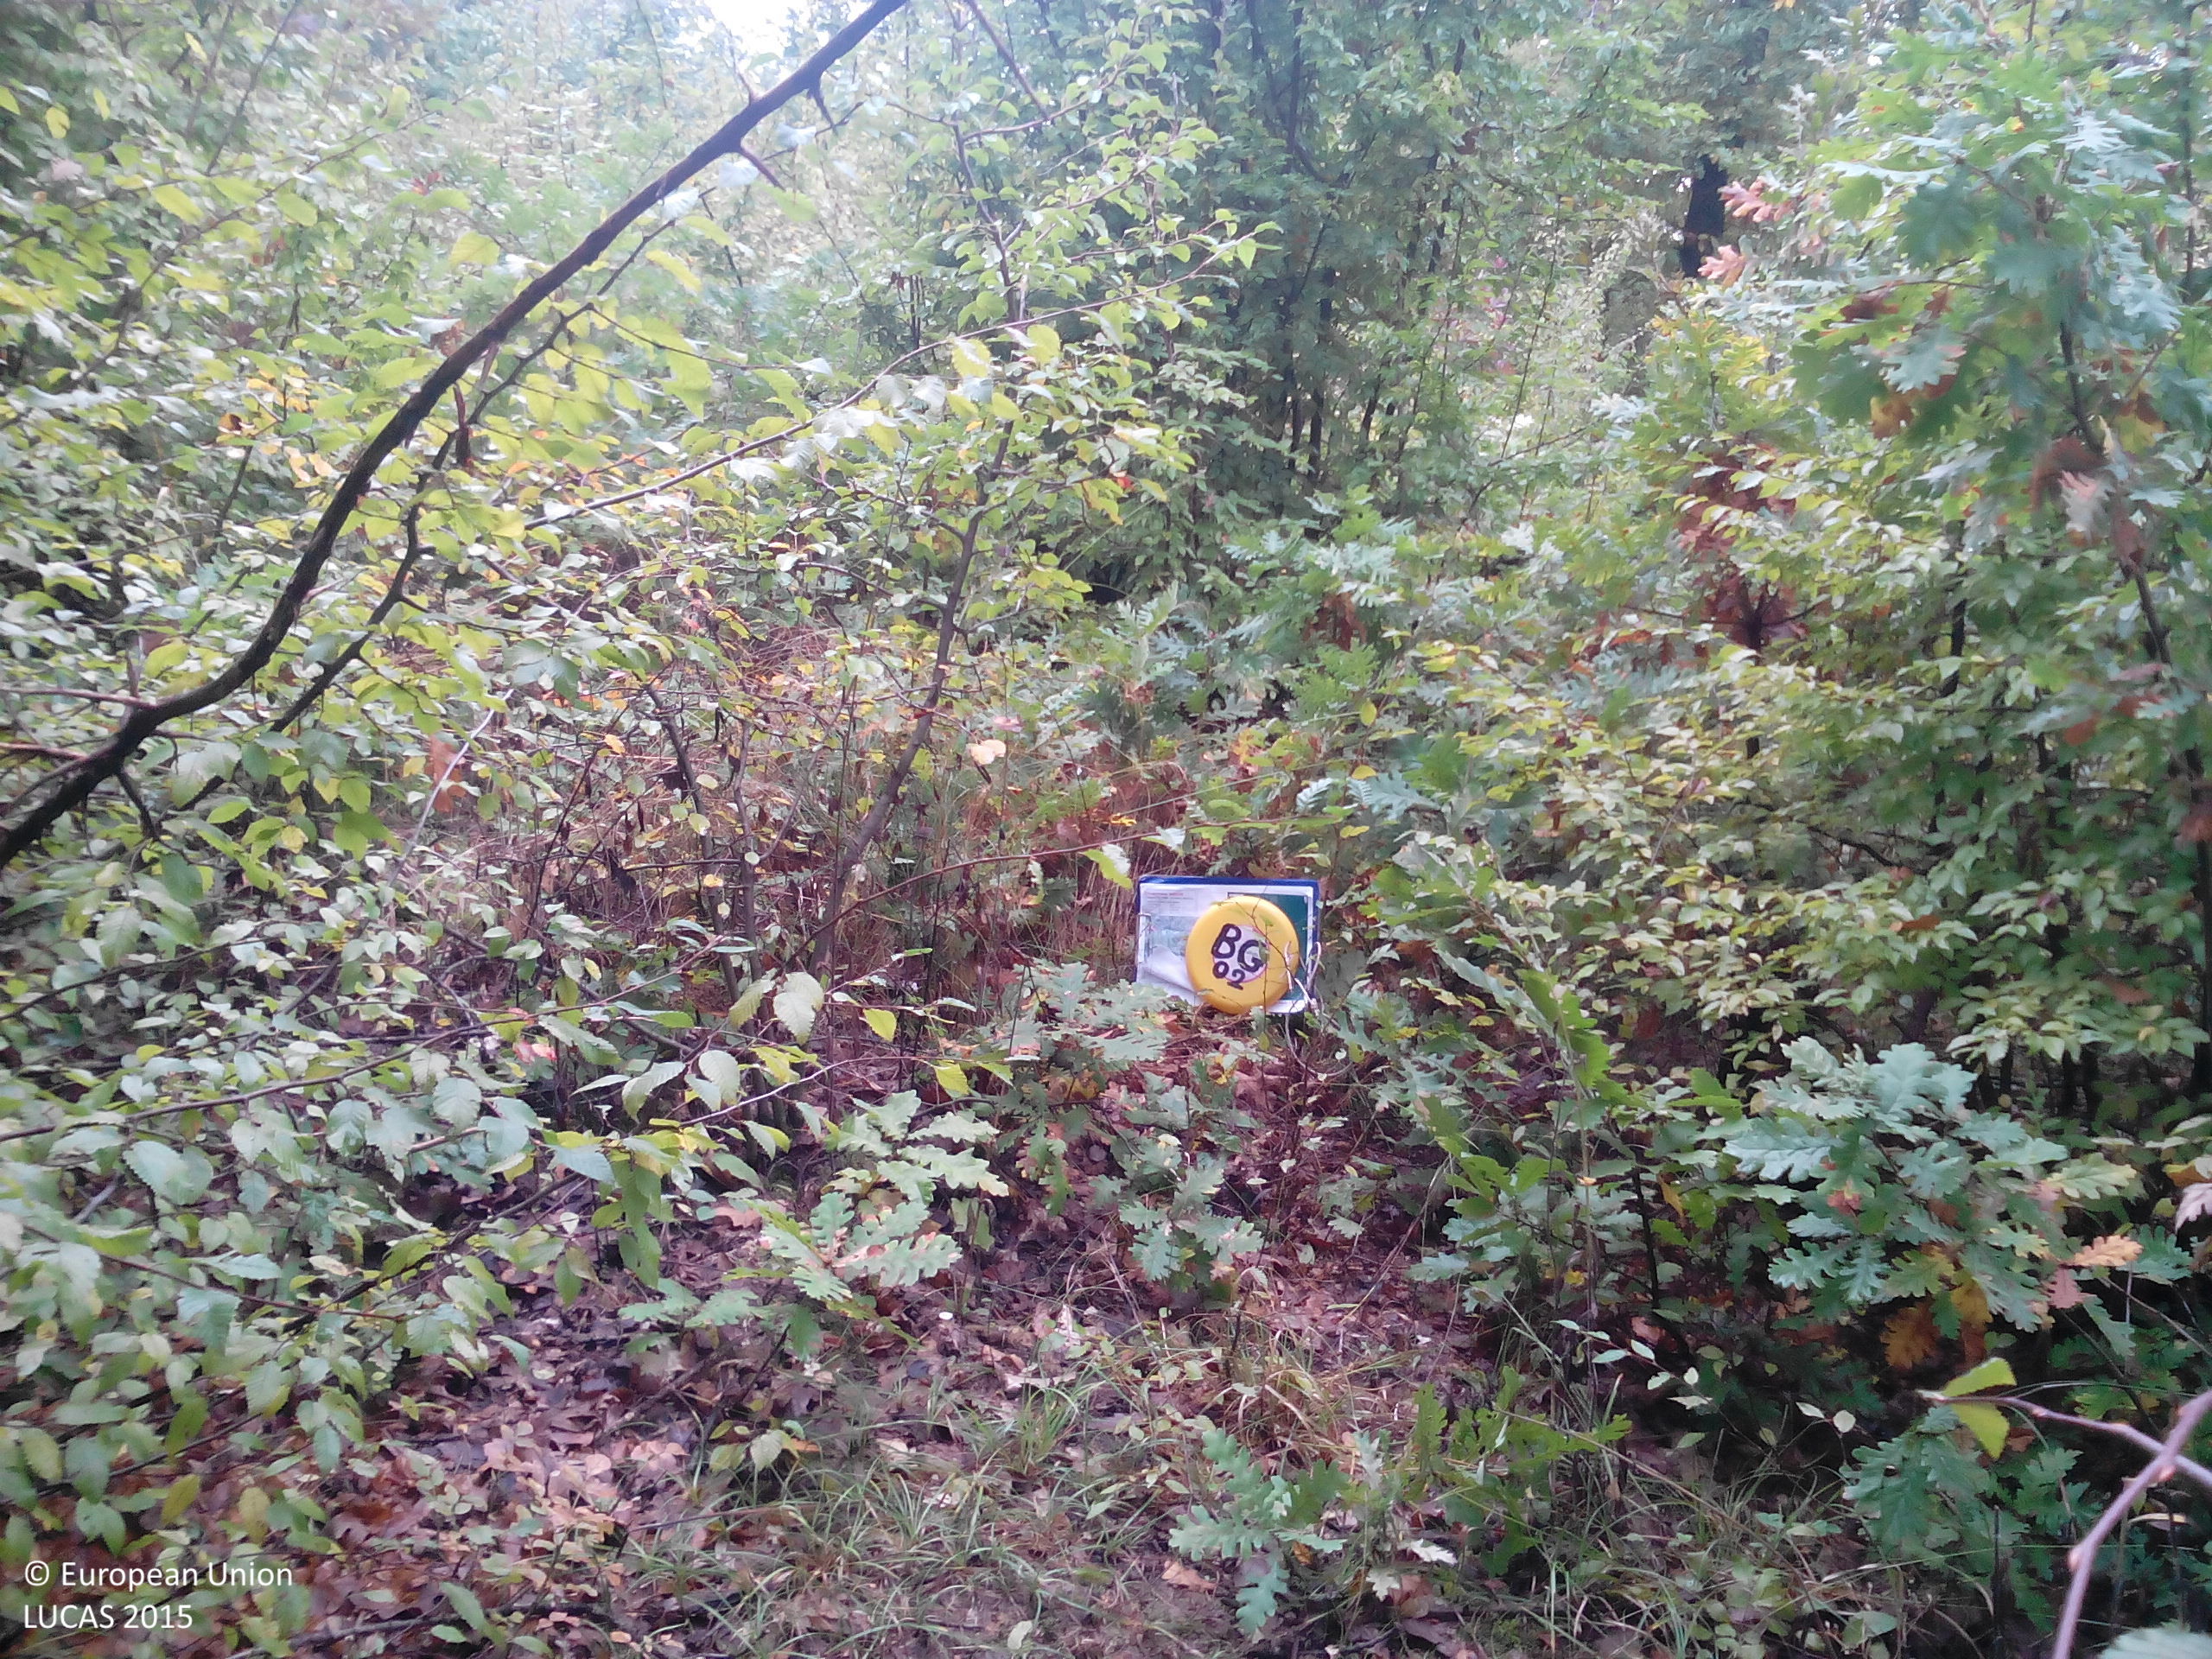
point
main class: Woodland
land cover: Broadleaved woodland
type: acidophilous oak and oak-birch forest
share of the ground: > 75 %
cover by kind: broadleaved forest trees 90 %, shrubs 5 %, herbaceous plants 5 %
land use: Forestry
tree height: > 5 m
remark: Clear cut
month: October
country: BG
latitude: 43.1151
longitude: 24.0478
